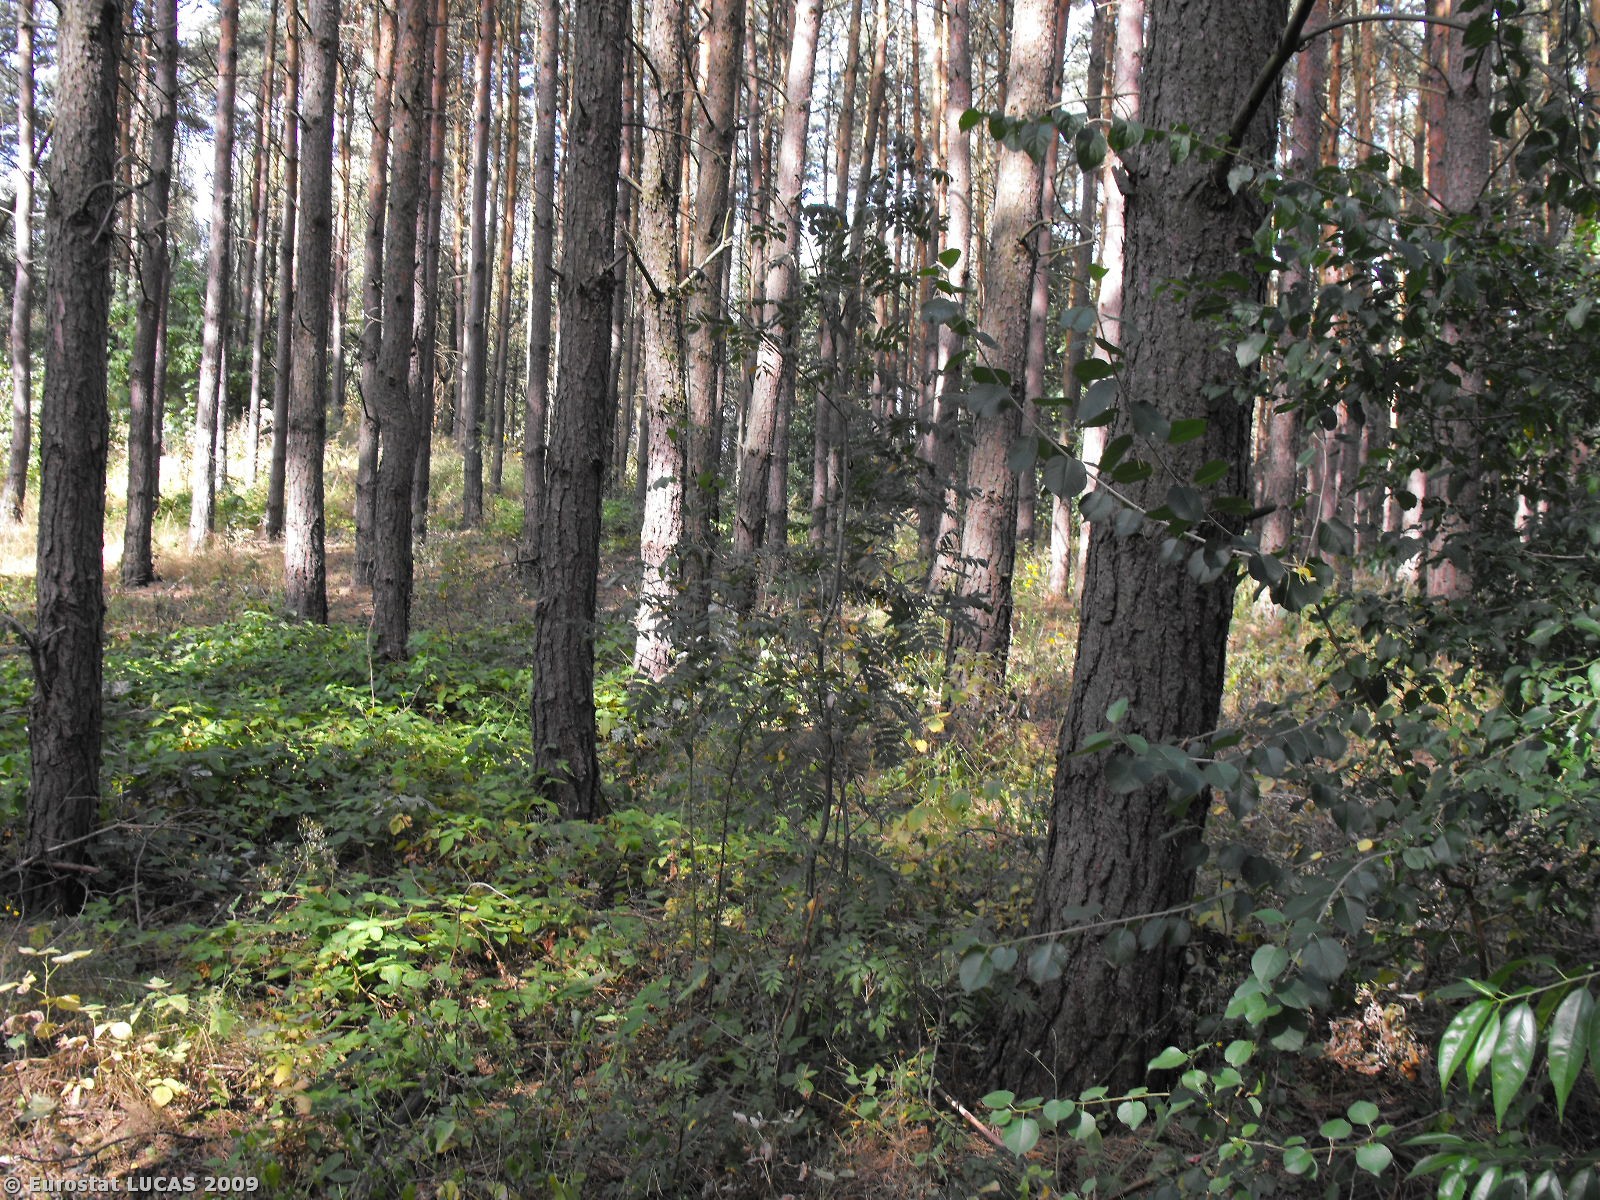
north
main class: Woodland
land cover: Mixed woodland
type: hemiboreal forest and nemoral coniferous forest and mixed broadleaved-coniferous forest
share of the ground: > 75 %
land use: Forestry
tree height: > 5 m
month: August
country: PL
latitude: 52.8488
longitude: 16.4962
